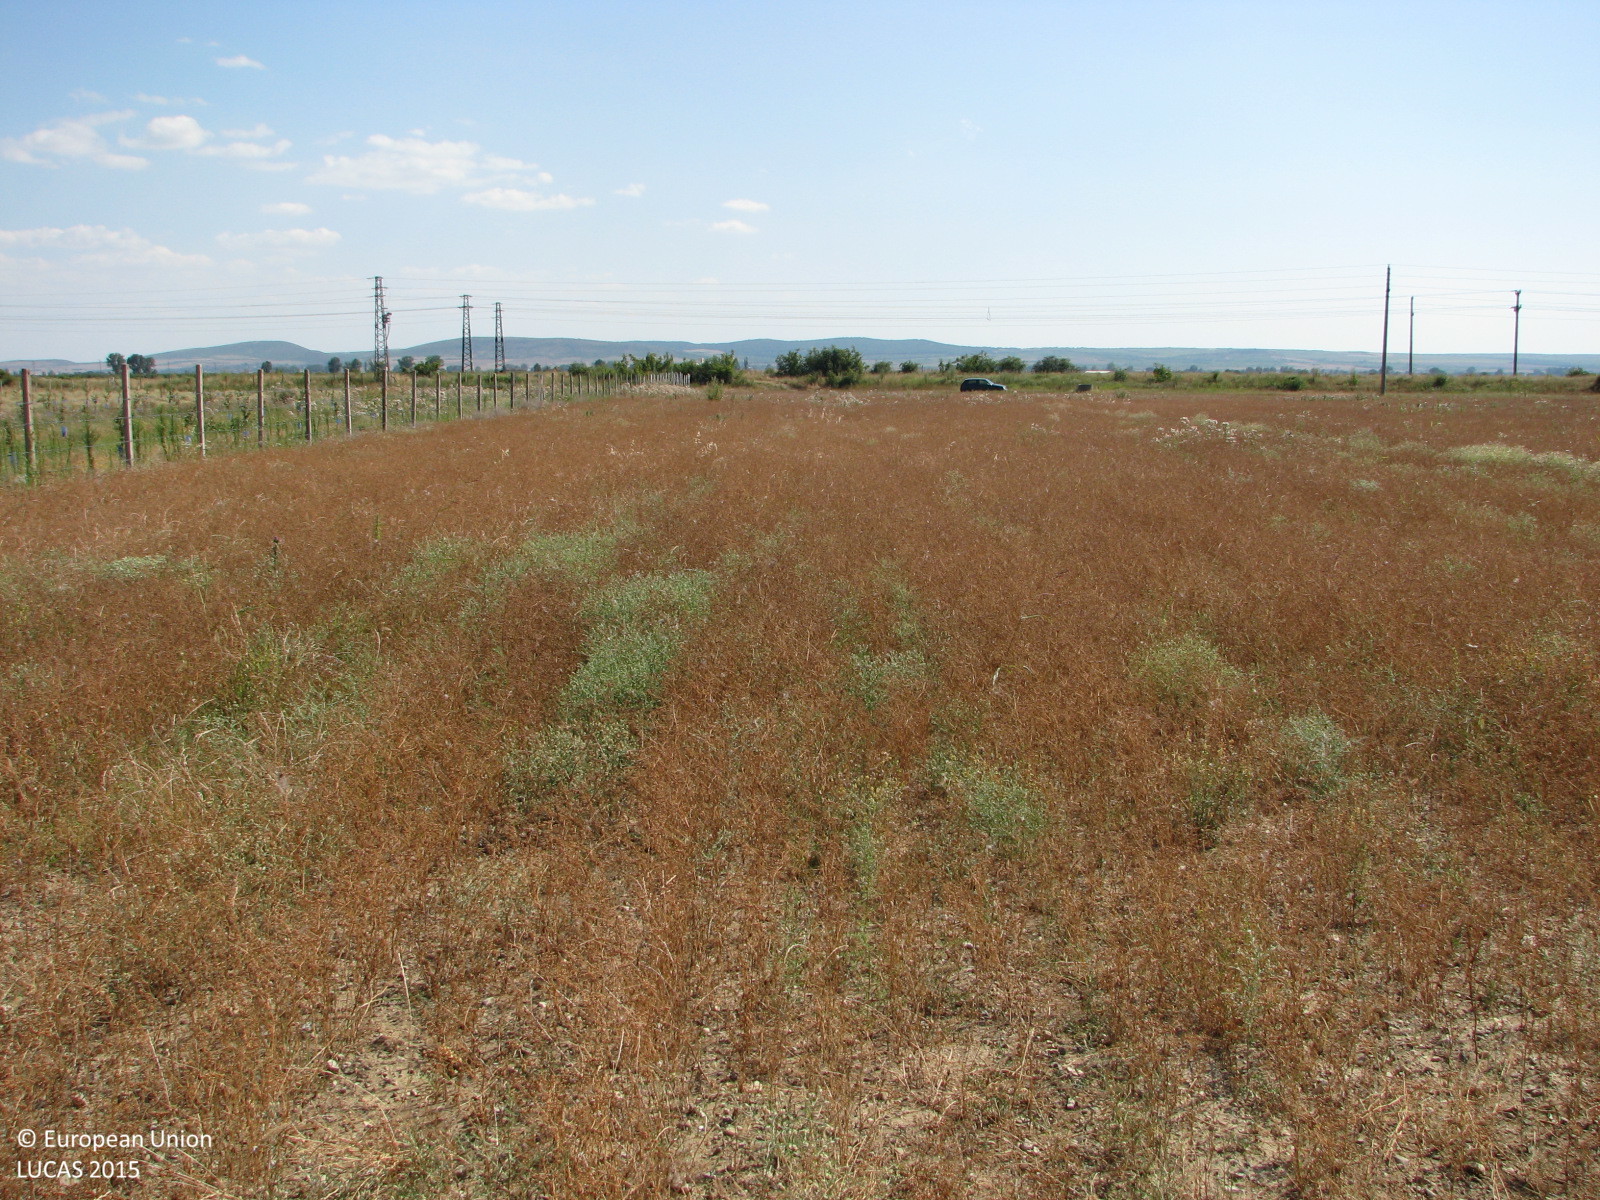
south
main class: Cropland
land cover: Other non-permanent industrial crops
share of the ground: > 75 %
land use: Agriculture (excluding fallow land and kitchen gardens)
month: July
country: BG
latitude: 42.6255
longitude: 26.3184
